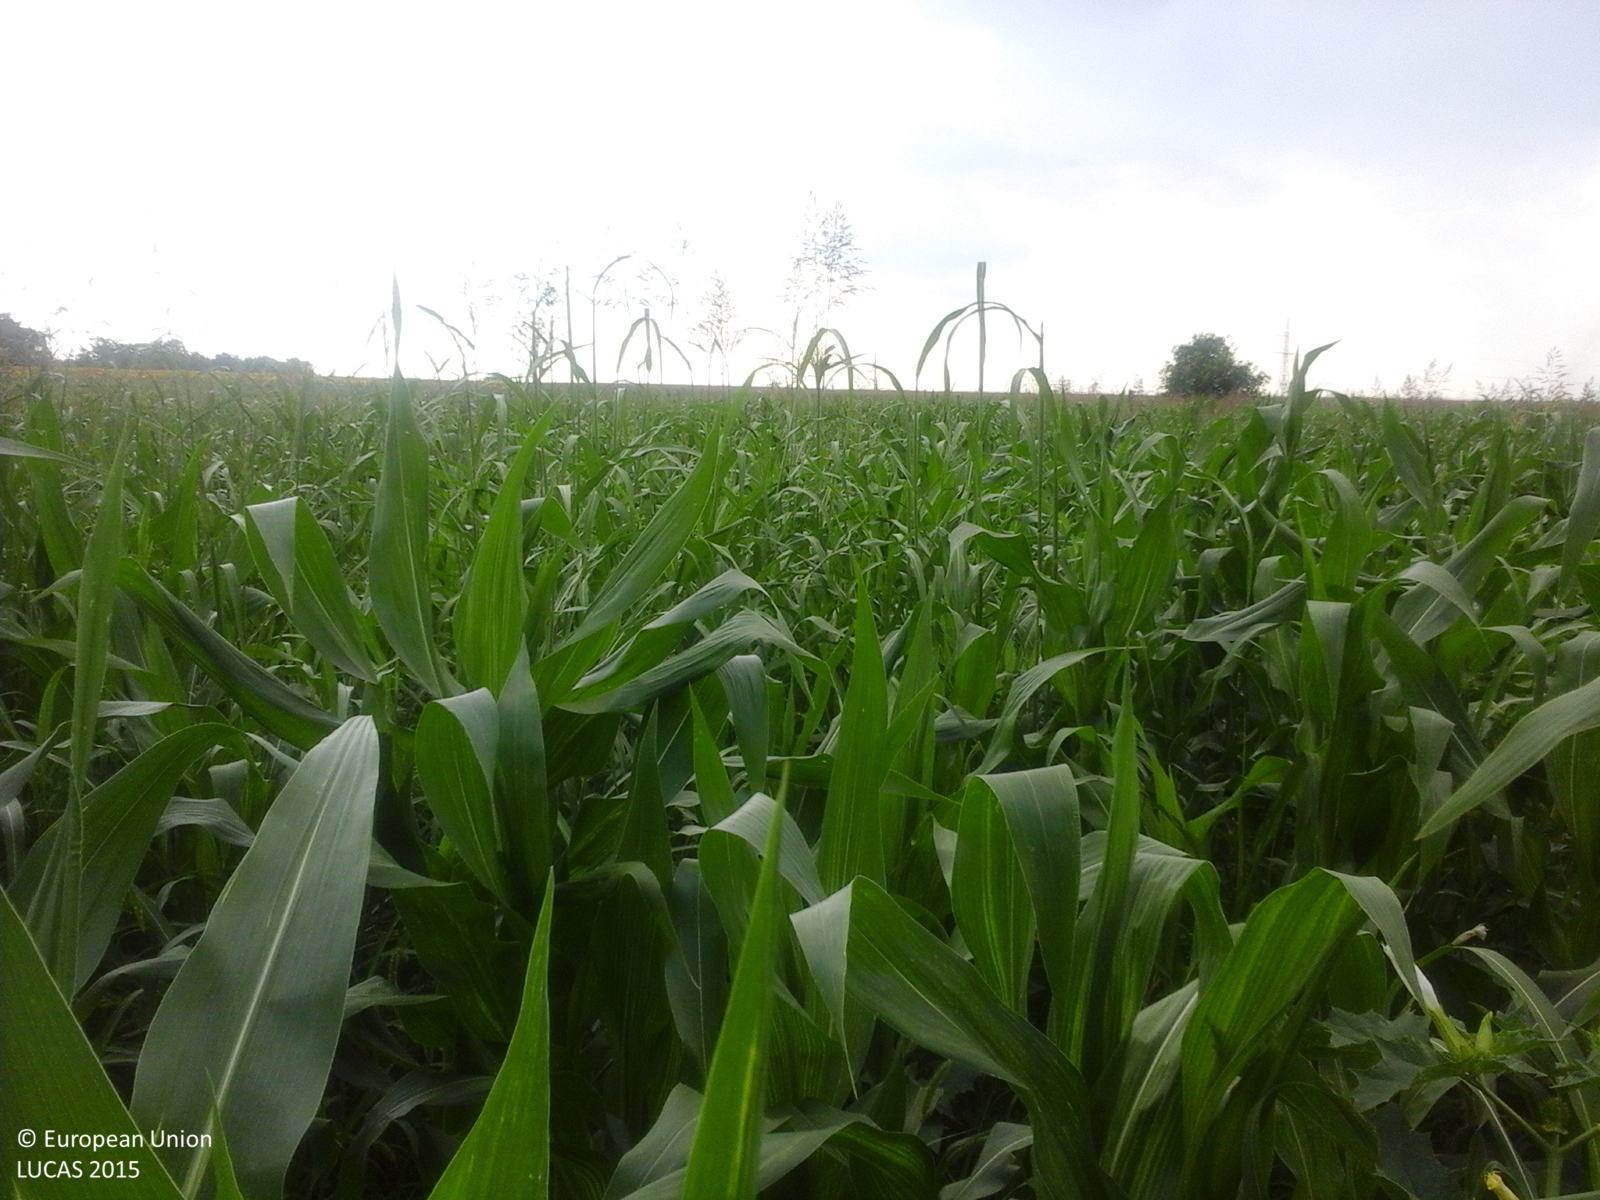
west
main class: Cropland
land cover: Maize
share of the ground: > 75 %
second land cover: Other fresh vegetables
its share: 25 - 50 %
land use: Agriculture (excluding fallow land and kitchen gardens)
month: July
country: RO
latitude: 43.7483
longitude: 25.7240
